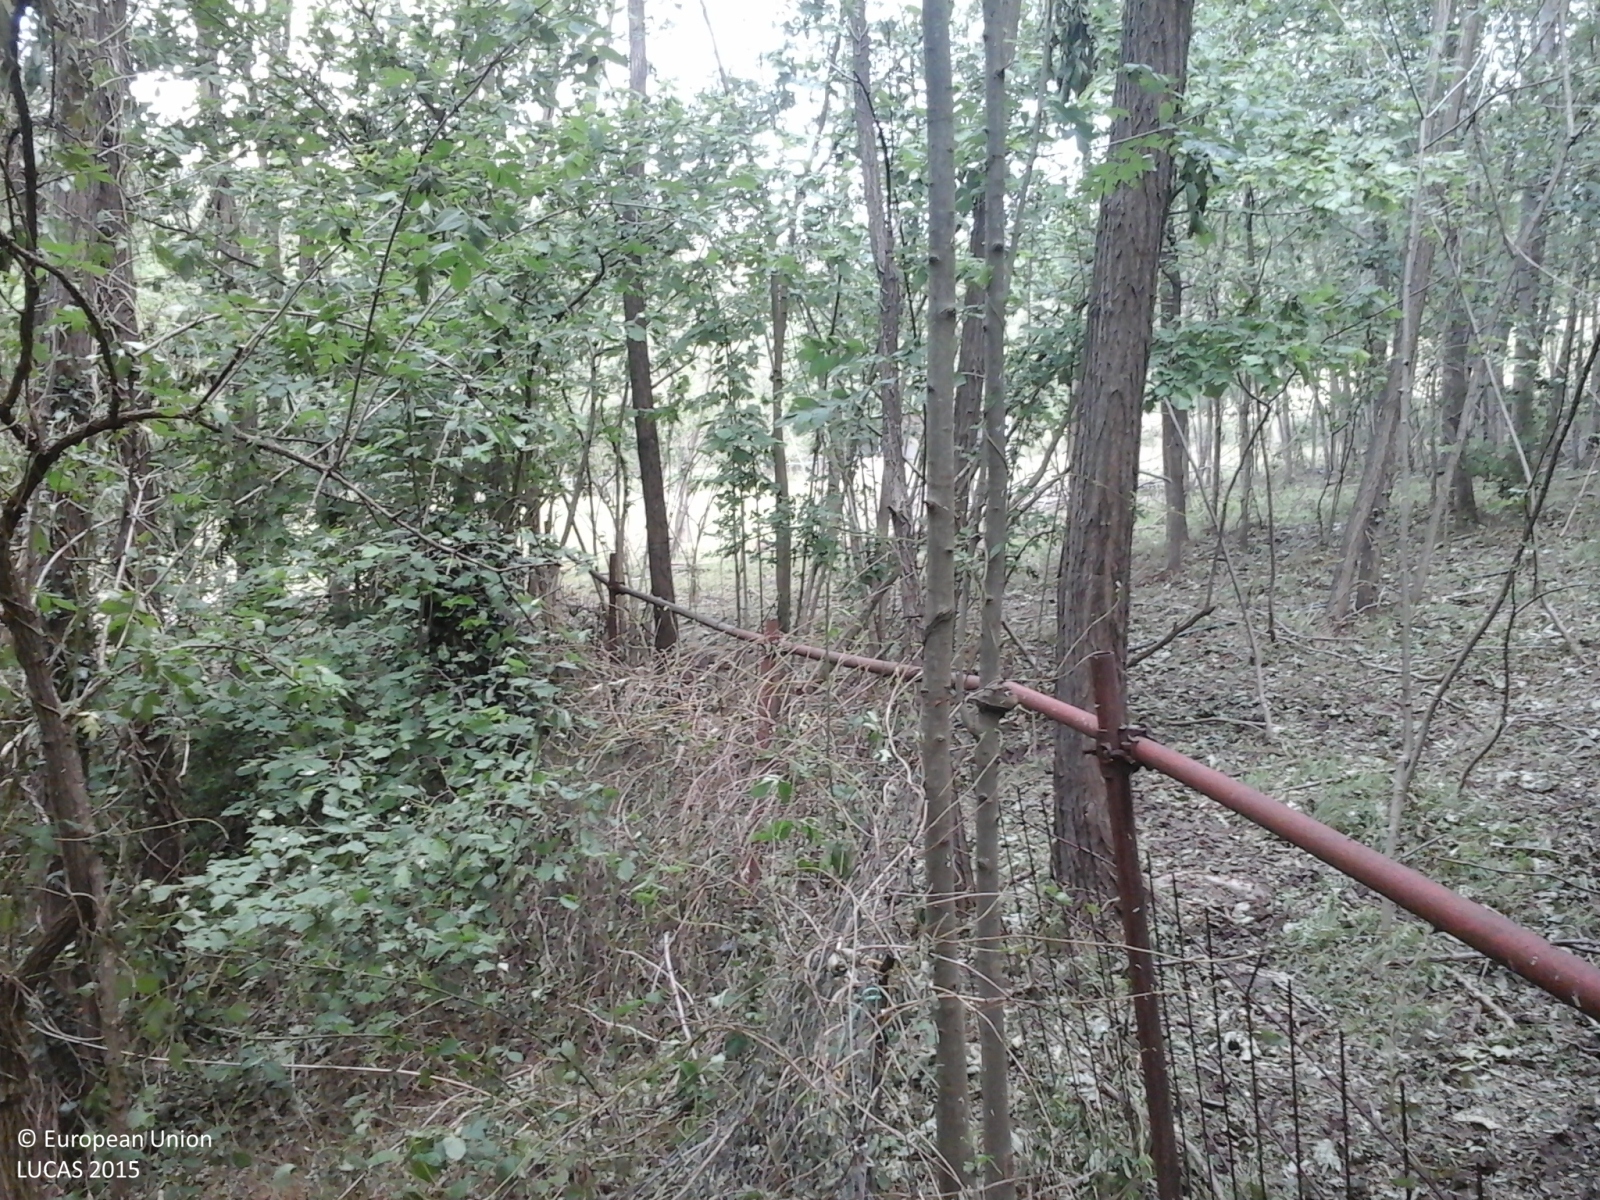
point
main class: Woodland
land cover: Broadleaved woodland
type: thermophilous deciduous forest
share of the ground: > 75 %
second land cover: Grassland without tree/shrub cover
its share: > 75 %
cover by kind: broadleaved forest trees 100 %
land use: Forestry
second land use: Agriculture (excluding fallow land and kitchen gardens)
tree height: > 5 m
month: May
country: IT
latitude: 44.7842
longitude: 7.2877
